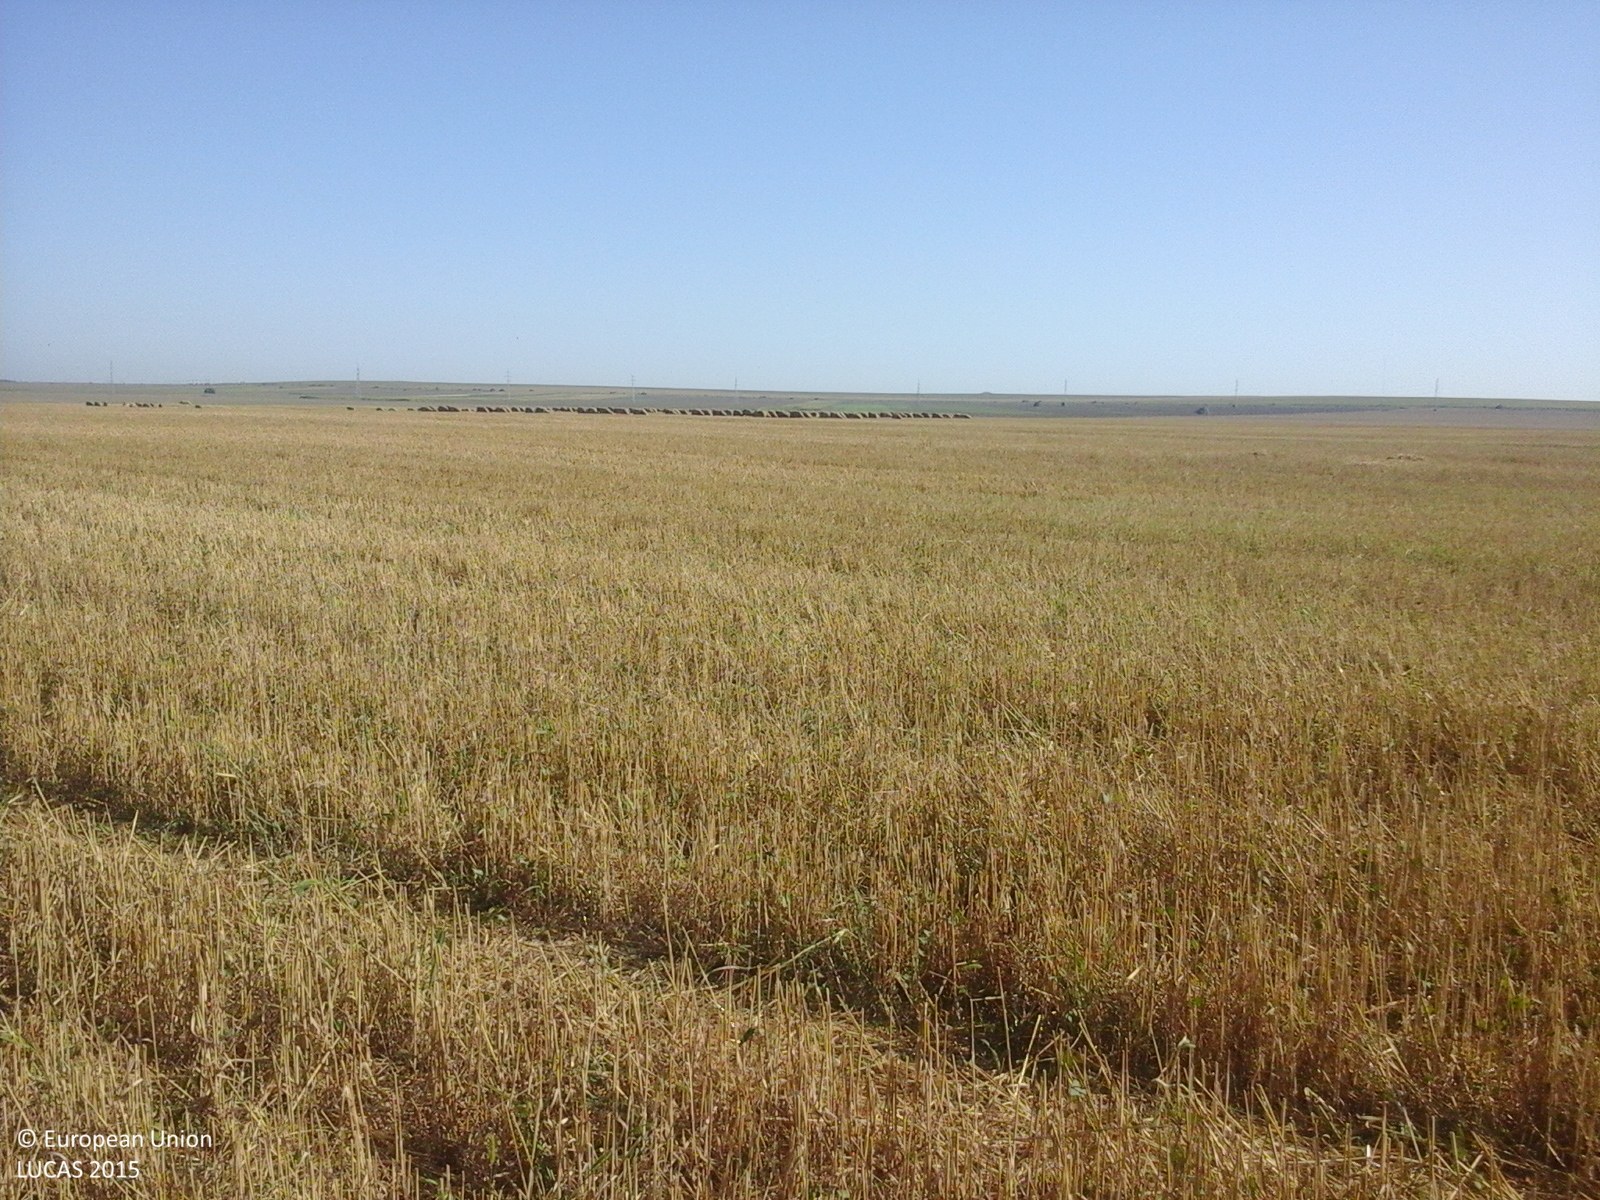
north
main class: Cropland
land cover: Common wheat
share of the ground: > 75 %
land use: Agriculture (excluding fallow land and kitchen gardens)
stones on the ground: < 10 %
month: August
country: RO
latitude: 44.6508
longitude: 28.1583
